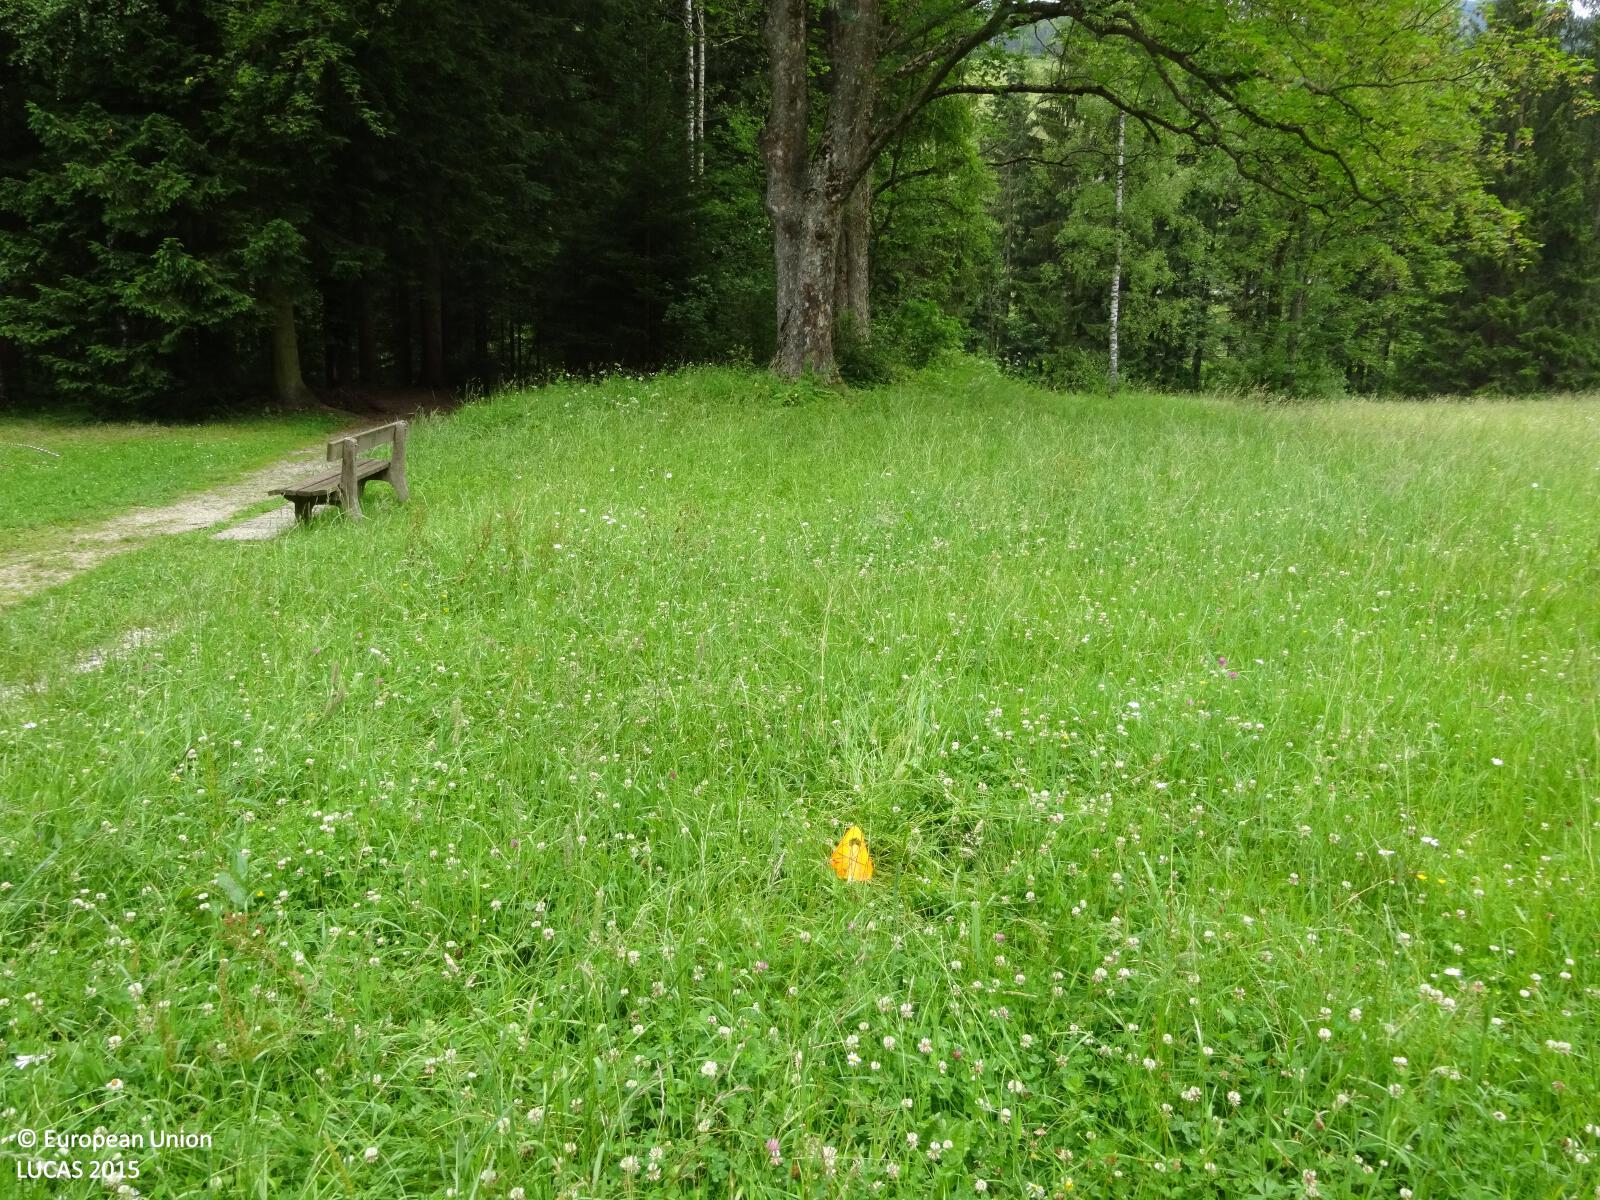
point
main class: Grassland
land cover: Grassland without tree/shrub cover
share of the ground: > 75 %
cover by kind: herbaceous plants 100 %
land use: Amenities, museums, leisure
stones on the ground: < 10 %
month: June
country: AT
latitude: 47.6052
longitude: 15.7348
